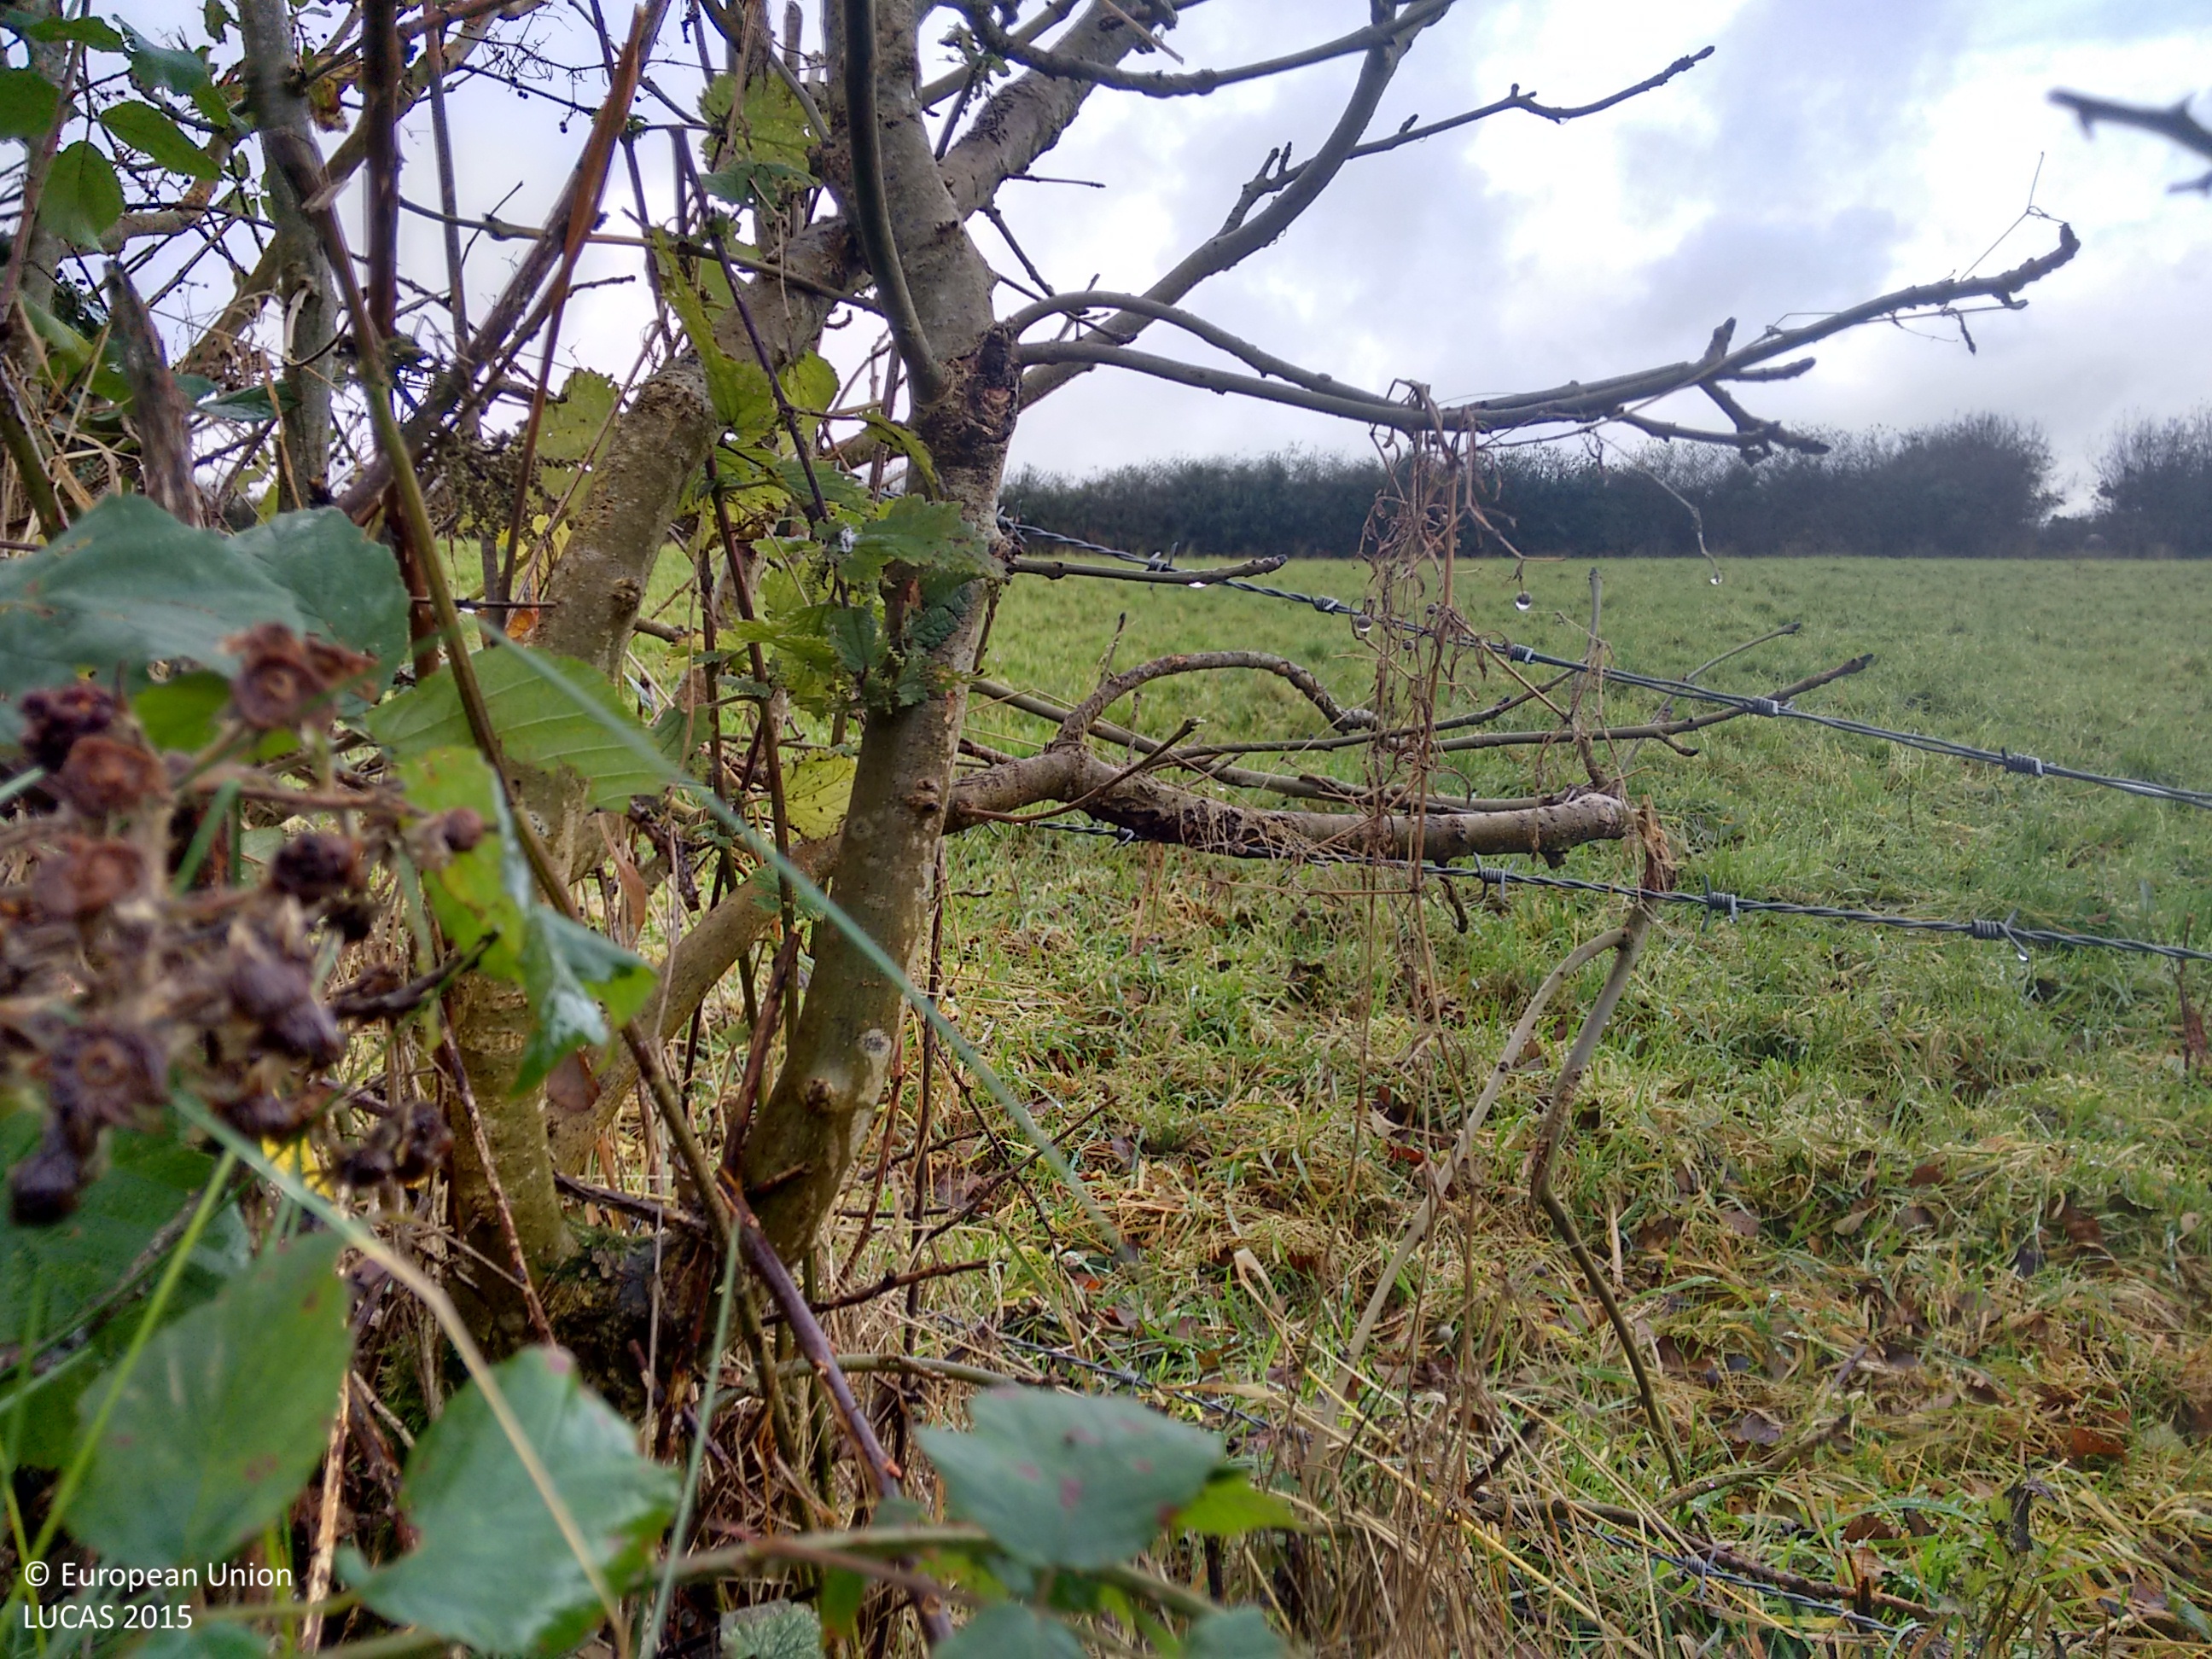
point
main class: Grassland
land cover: Grassland without tree/shrub cover
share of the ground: > 75 %
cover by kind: herbaceous plants 90 %, shrubs 5 %, consolidated bare surface 5 %
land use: Agriculture (excluding fallow land and kitchen gardens)
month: November
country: IE
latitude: 53.1292
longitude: -7.4794
